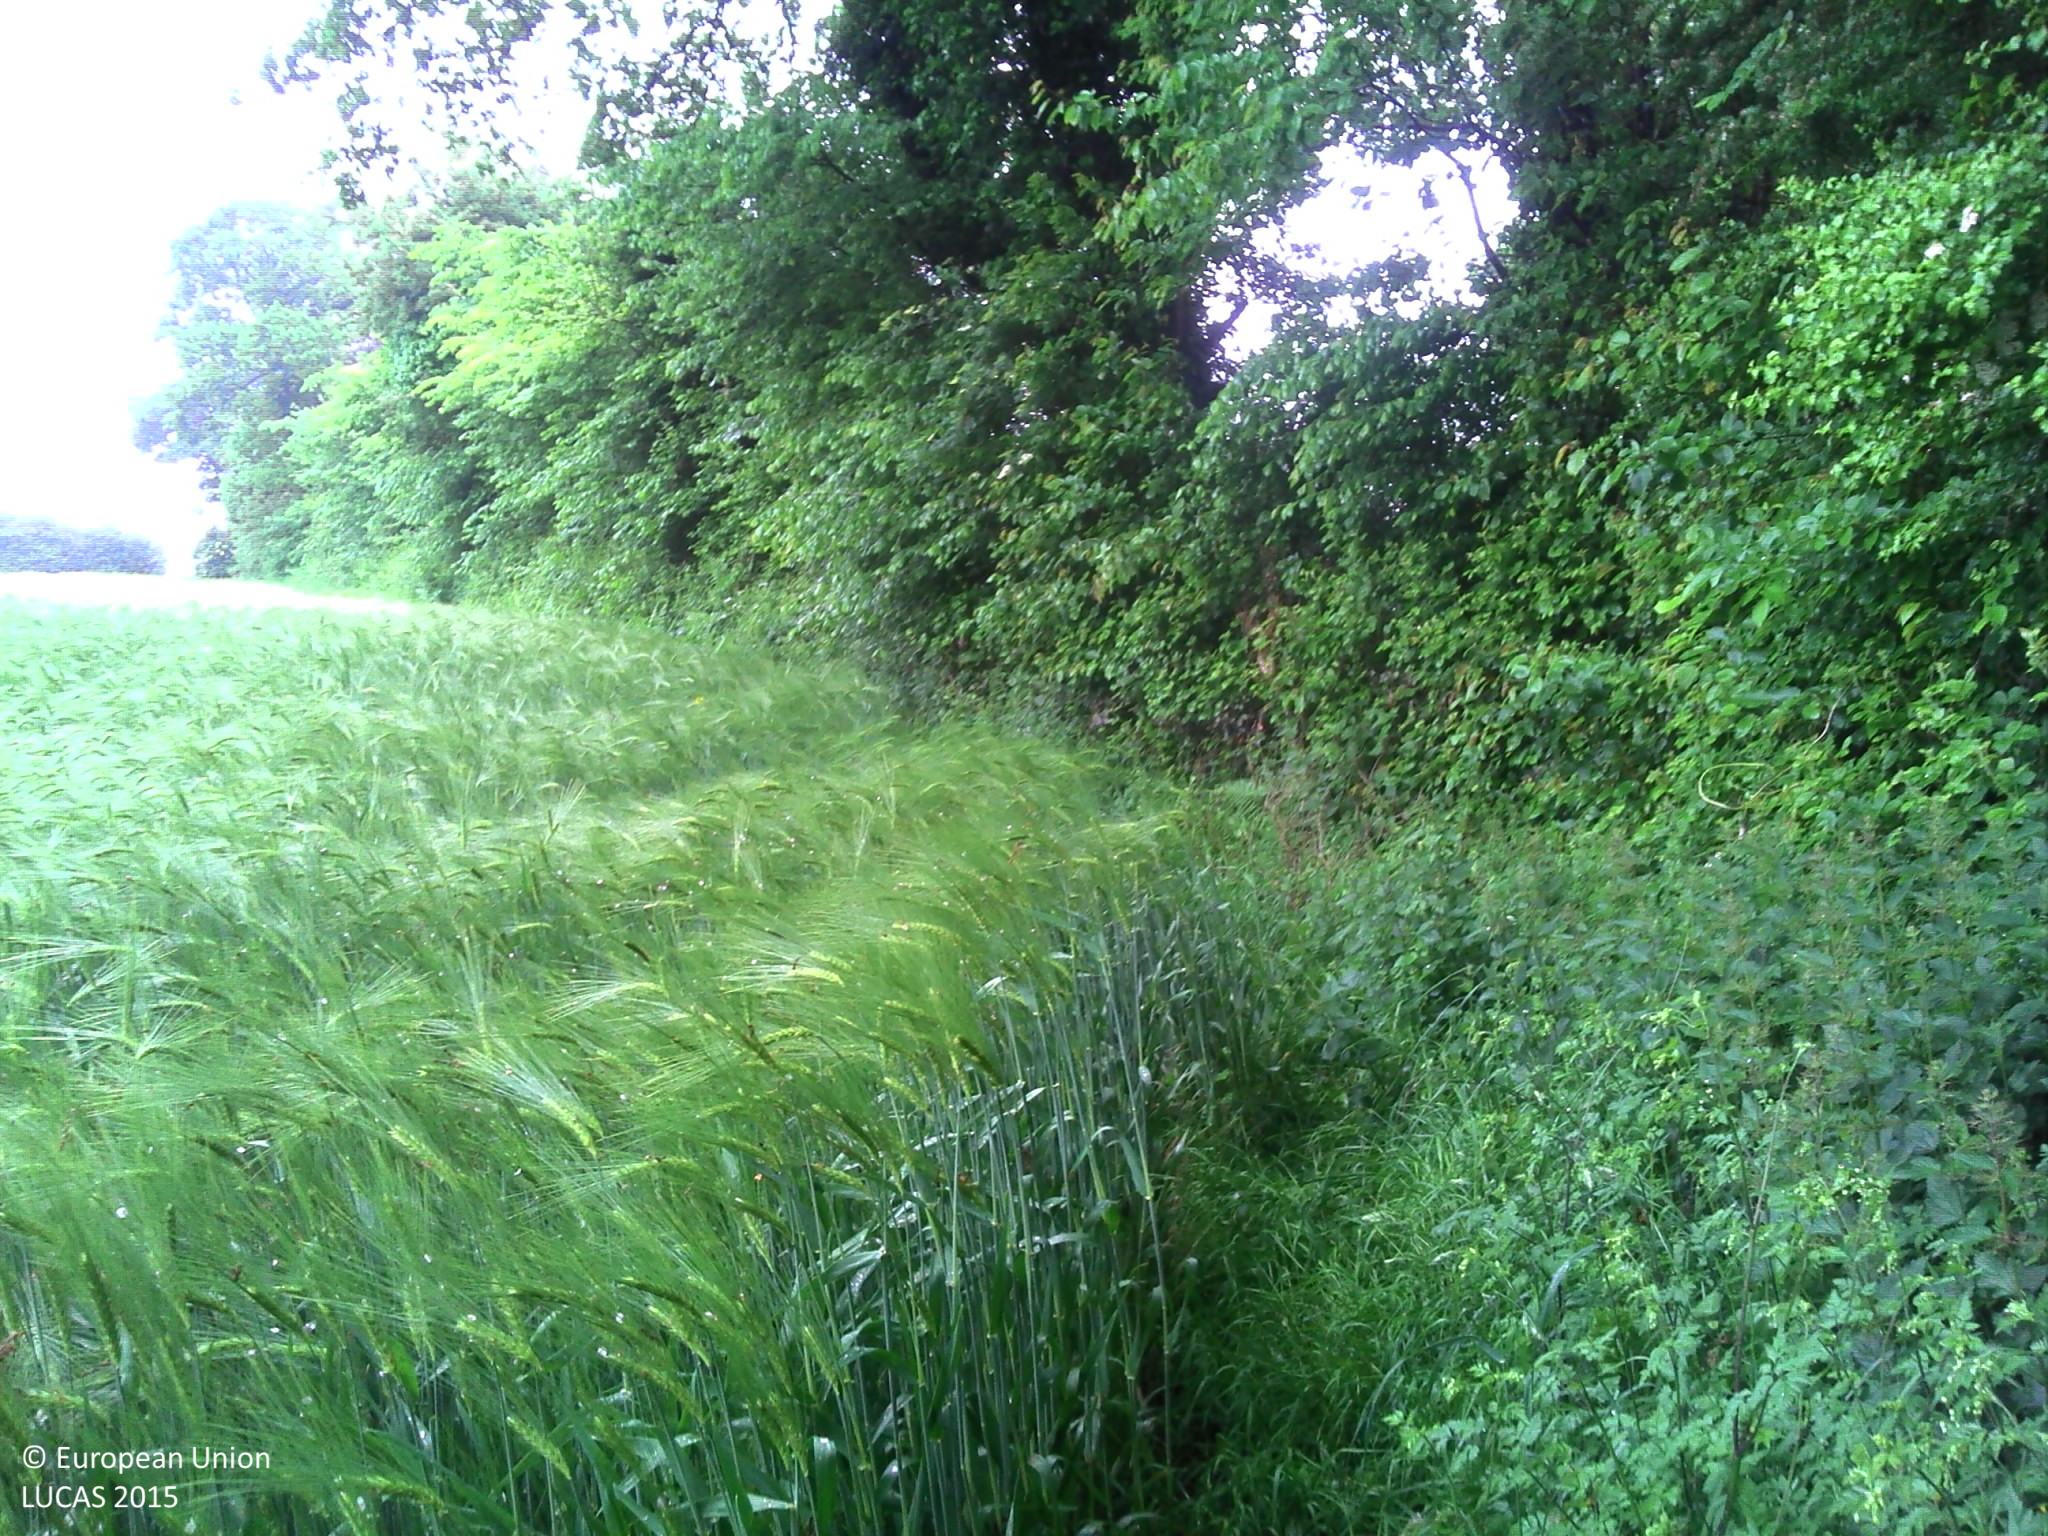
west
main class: Cropland
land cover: Barley
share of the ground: > 75 %
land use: Agriculture (excluding fallow land and kitchen gardens)
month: June
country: FR
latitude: 49.5251
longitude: -1.6983
